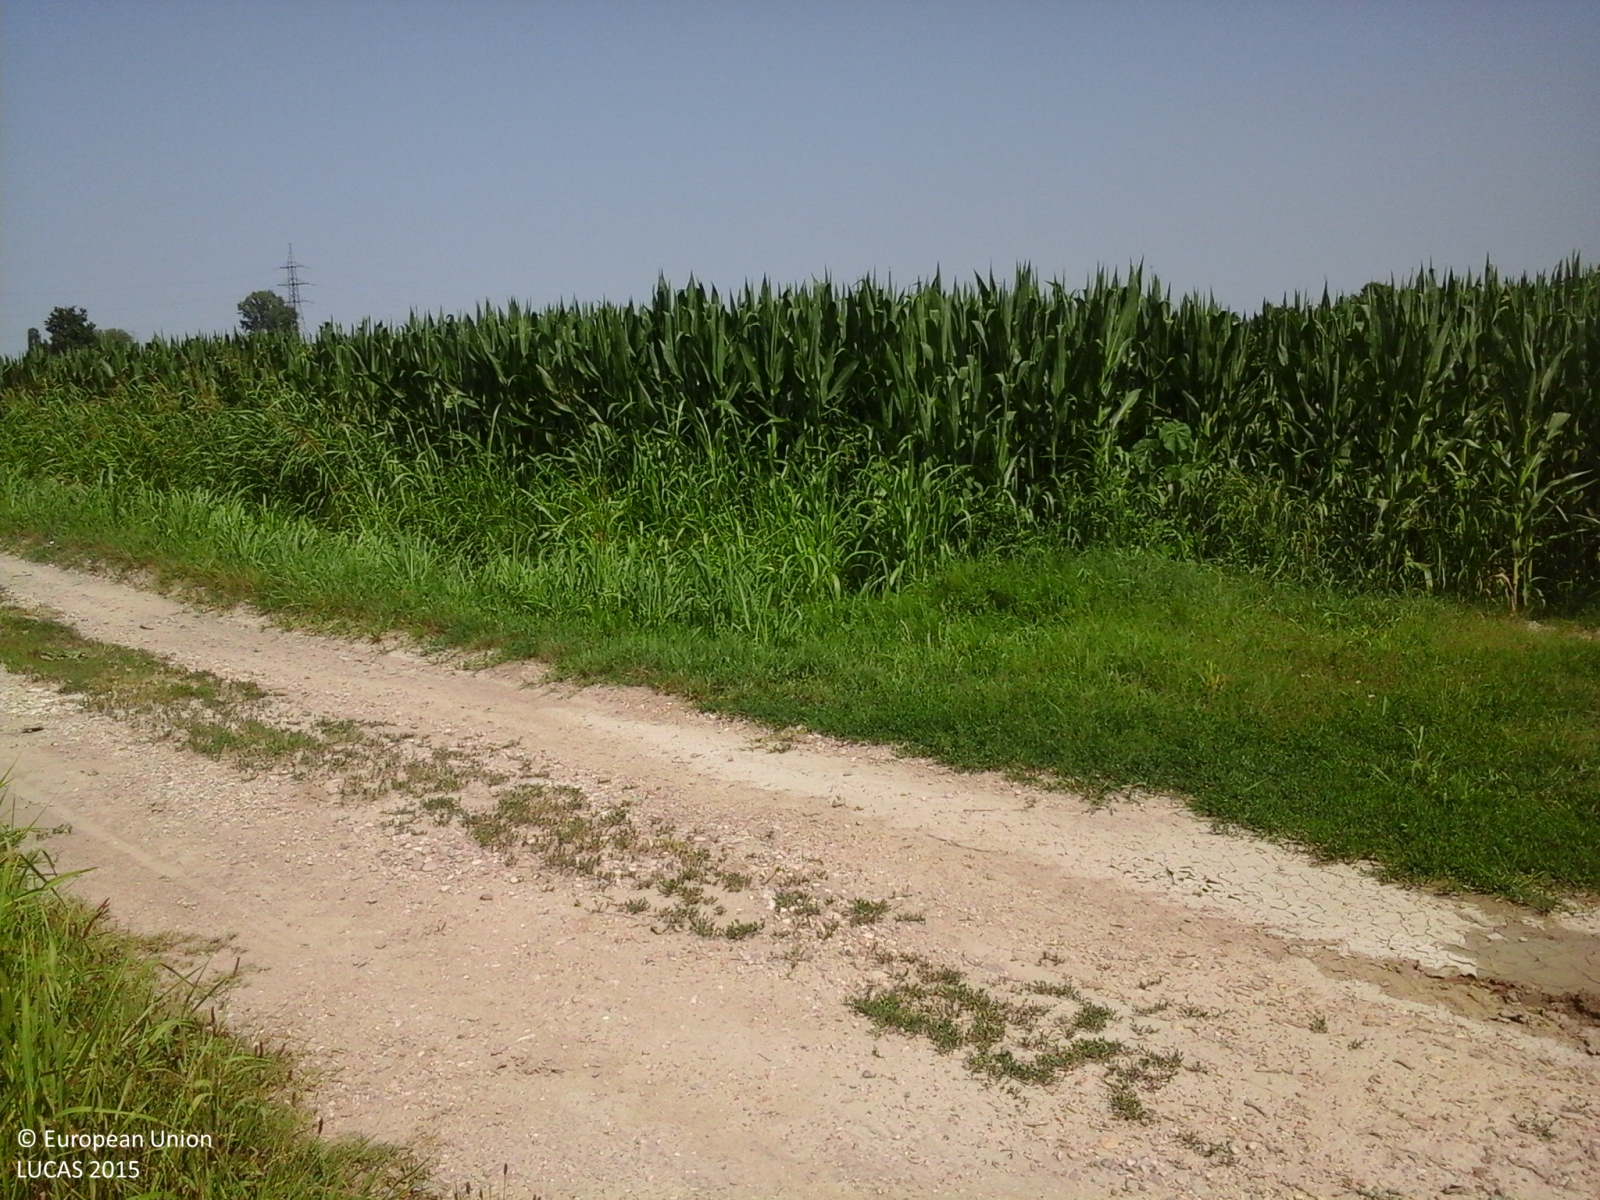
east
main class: Cropland
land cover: Maize
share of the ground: > 75 %
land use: Agriculture (excluding fallow land and kitchen gardens)
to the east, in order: Maize; Ditches and canals; Maize; Ditches and canals; Maize; Ditches and canals; Maize
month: July
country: IT
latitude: 45.3025
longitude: 10.8784
